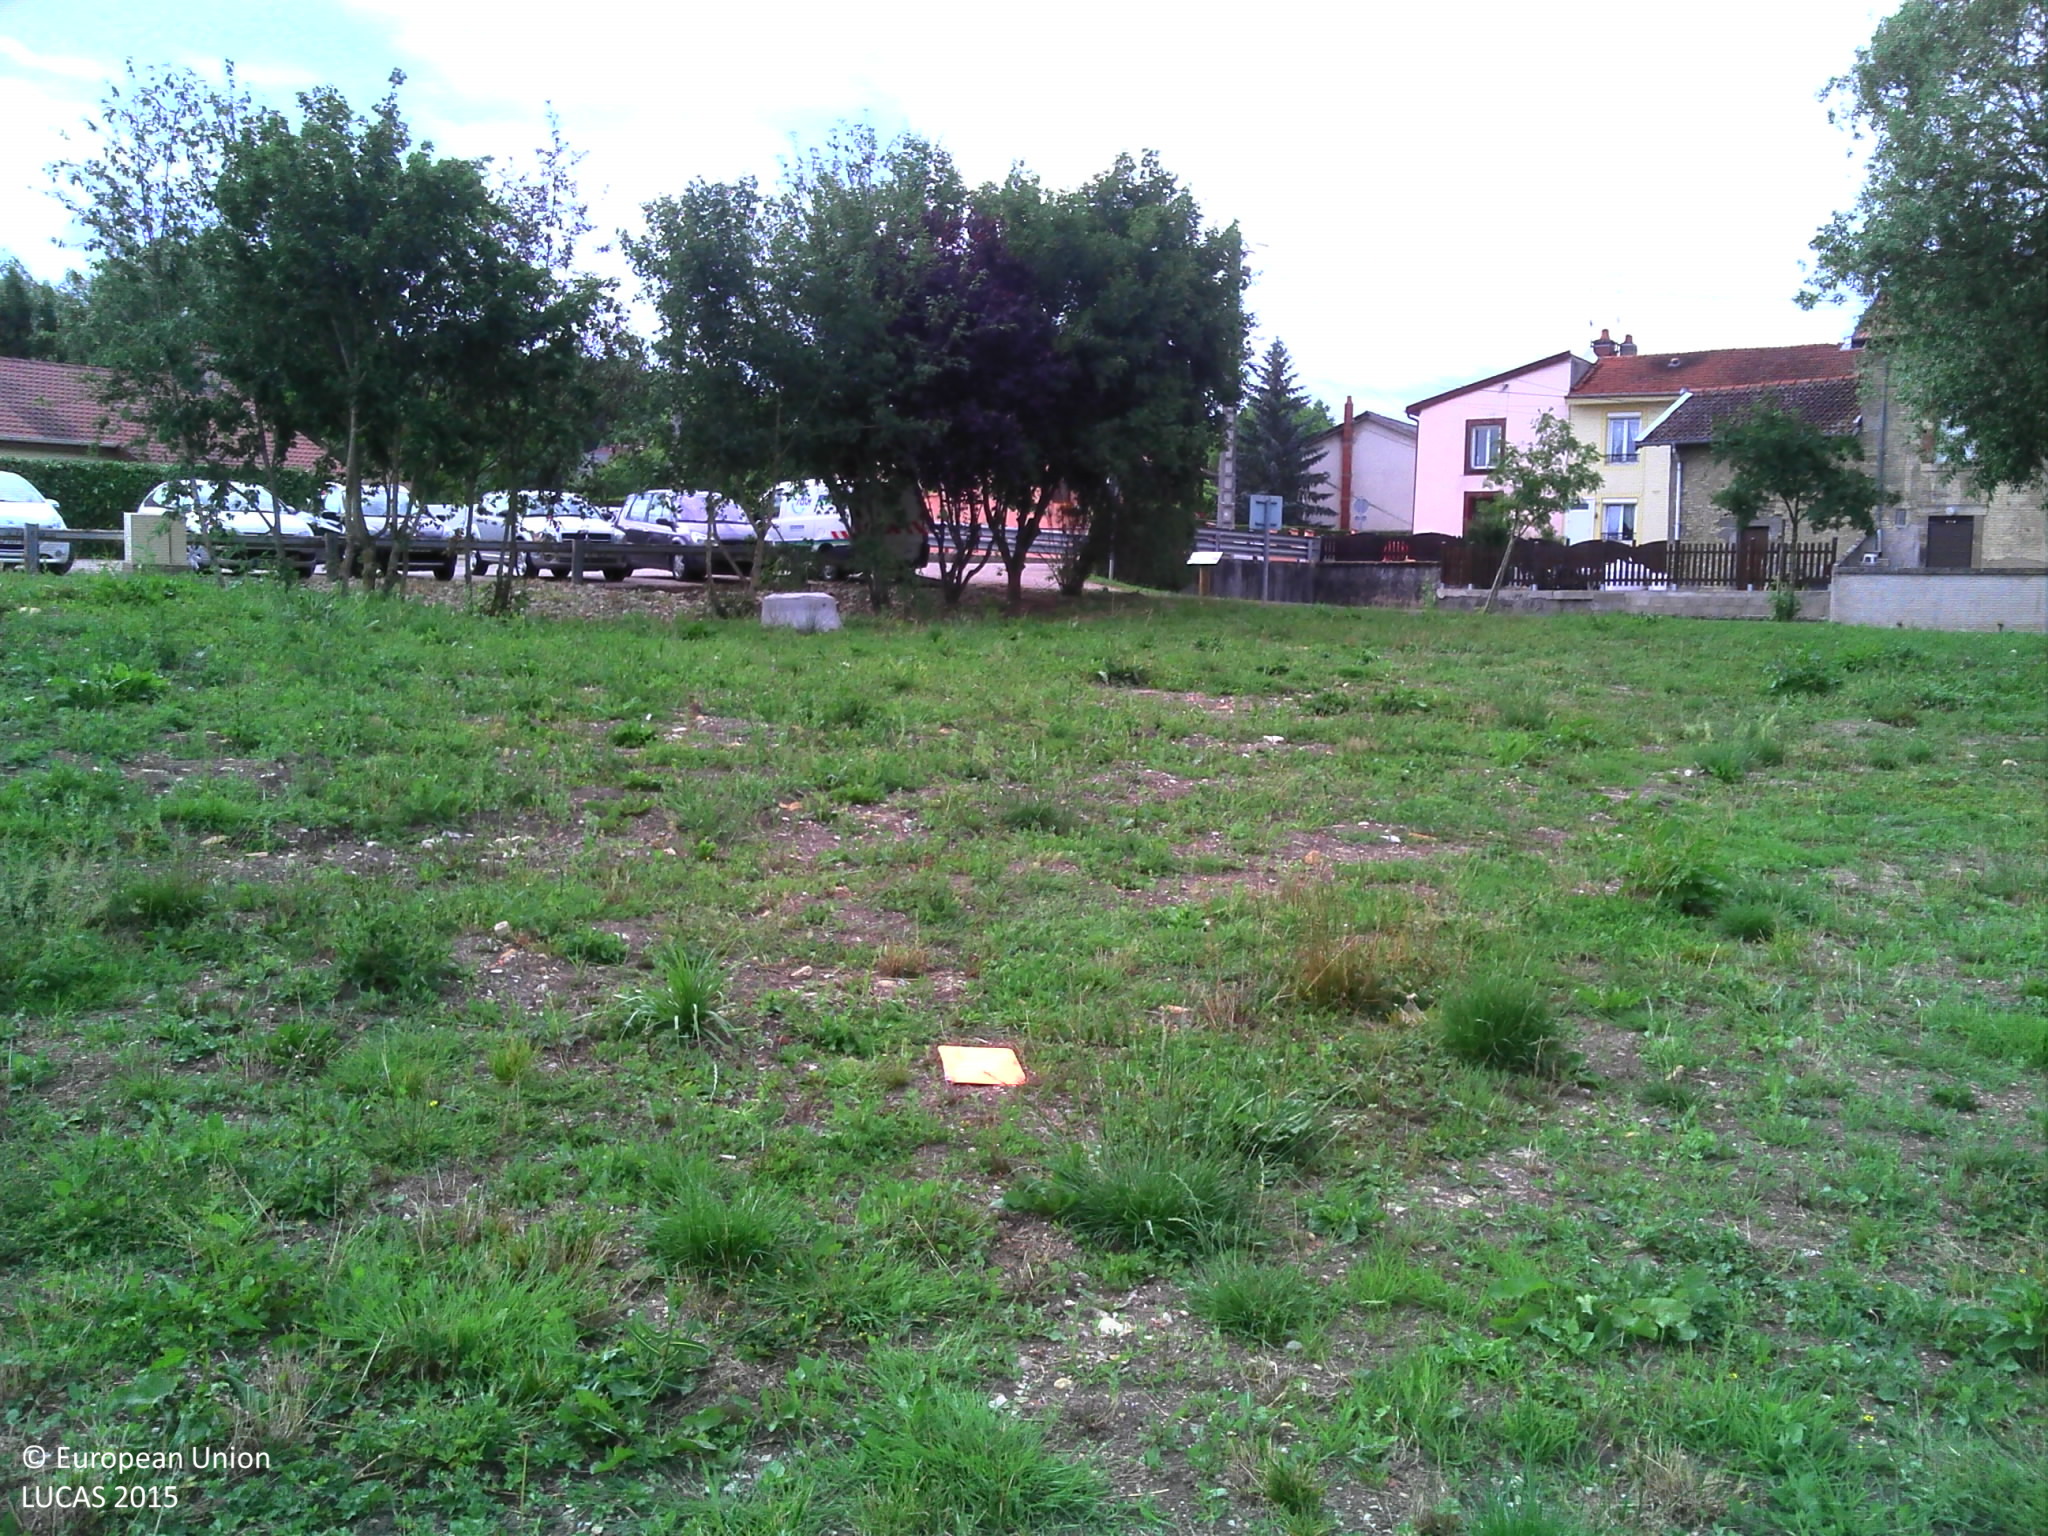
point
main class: Grassland
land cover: Spontaneously vegetated surfaces
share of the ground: > 75 %
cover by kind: herbaceous plants 100 %
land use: Amenities, museums, leisure
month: June
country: FR
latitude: 48.6538
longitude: 6.4844
